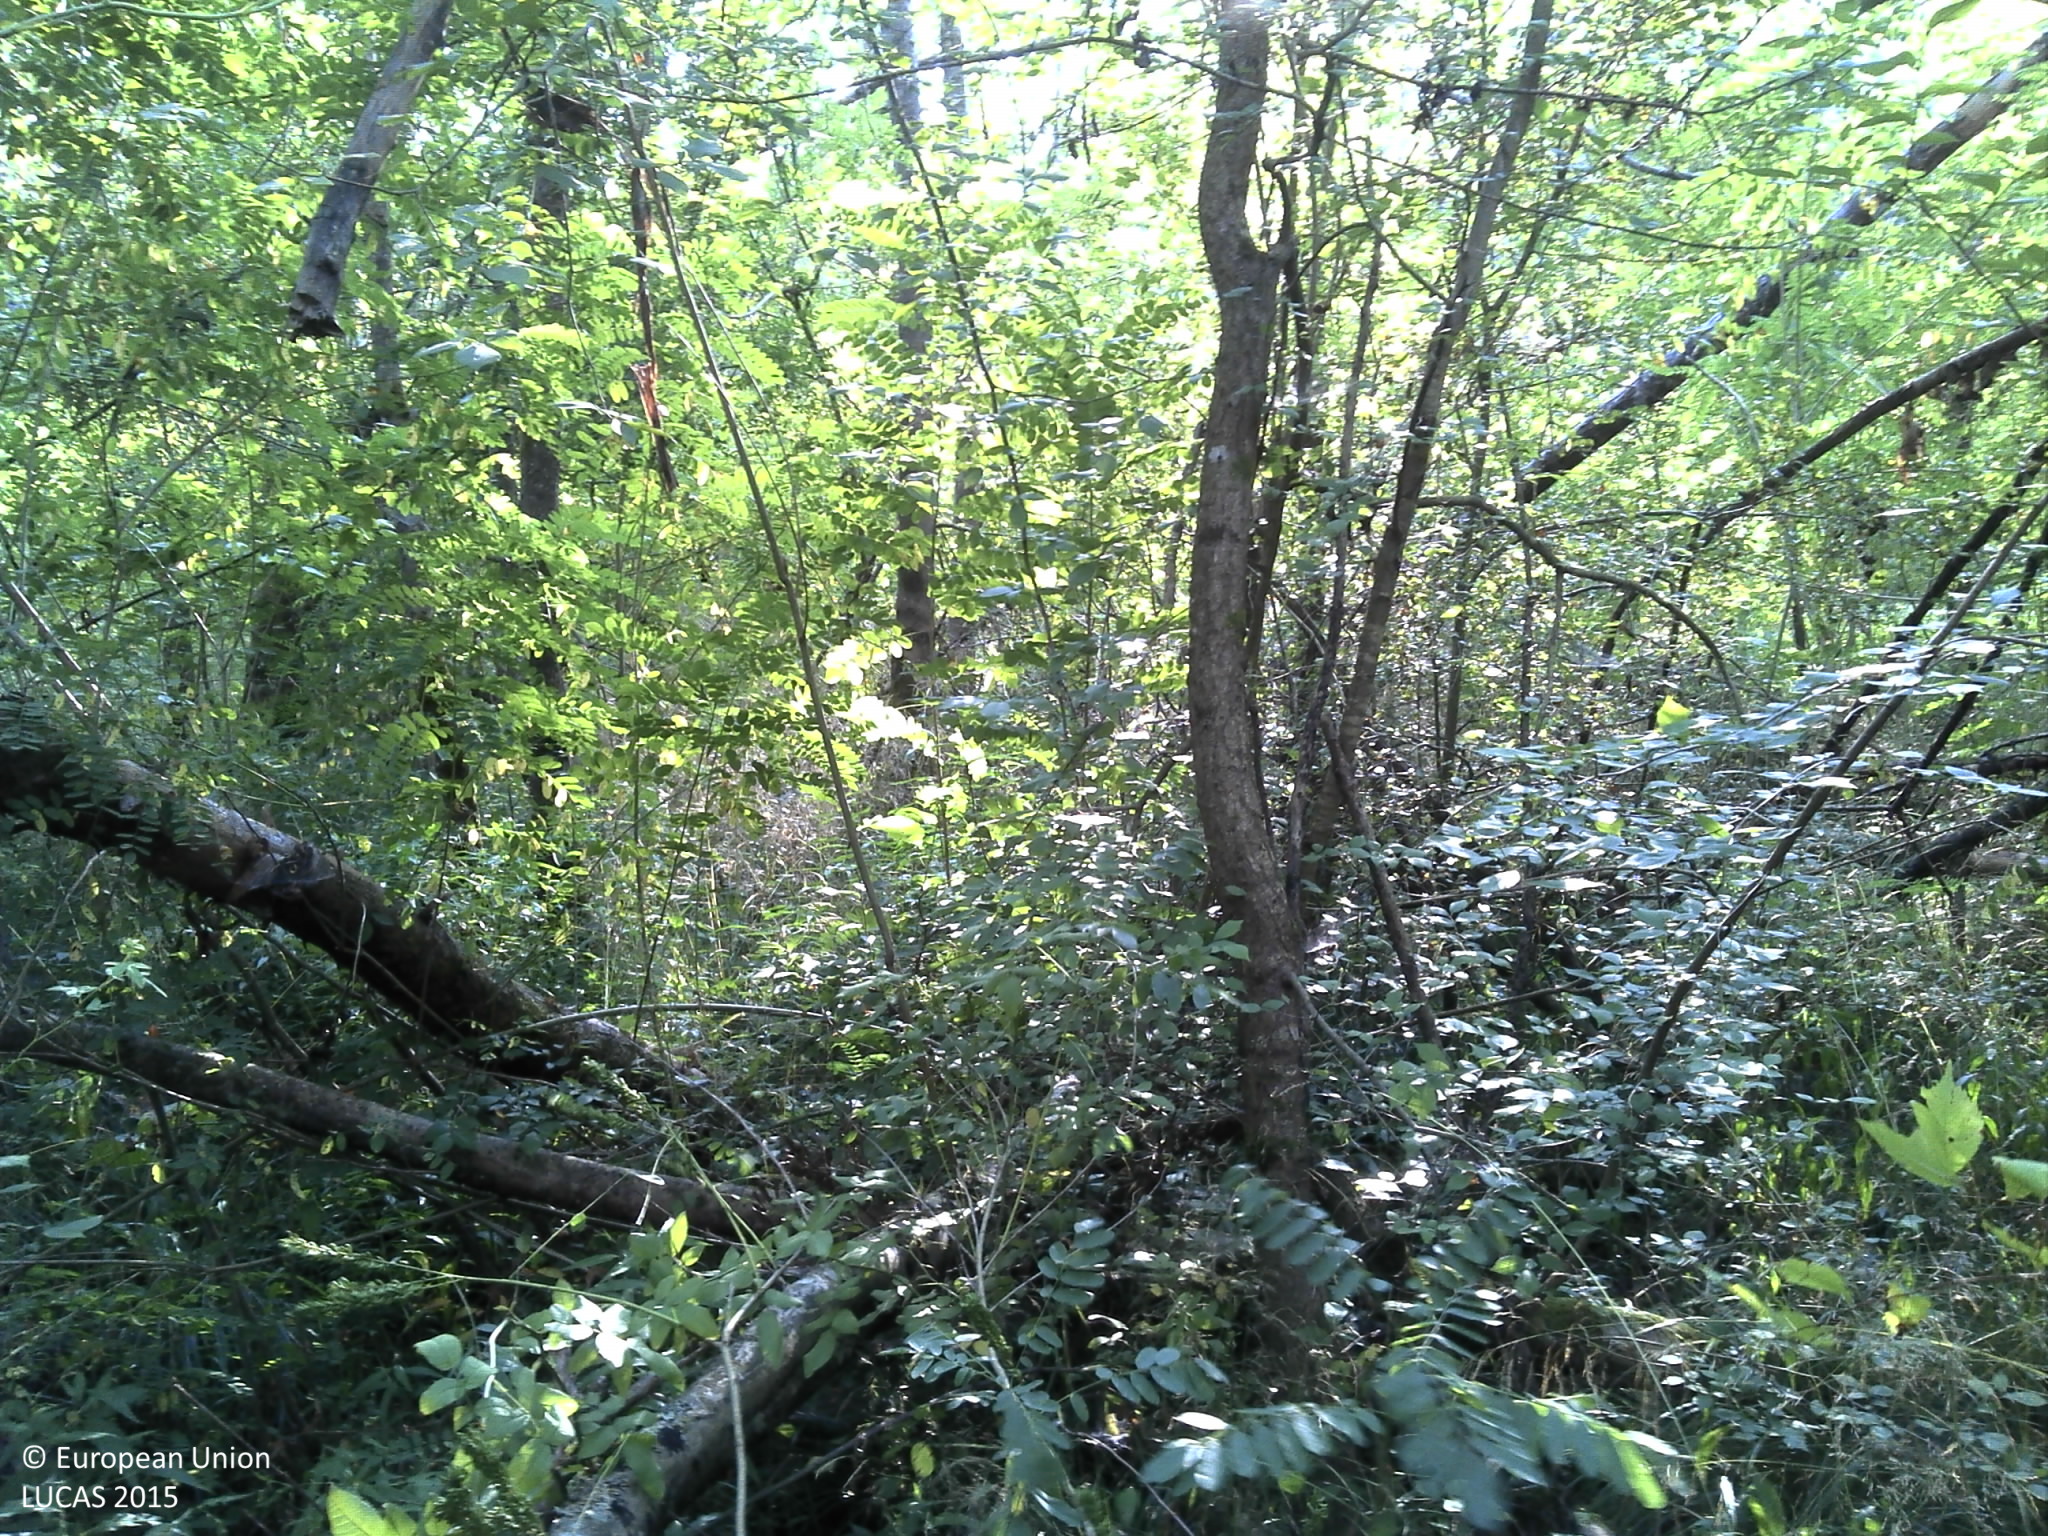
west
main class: Woodland
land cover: Broadleaved woodland
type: acidophilous oak and oak-birch forest
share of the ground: > 75 %
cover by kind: broadleaved forest trees 100 %
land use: Forestry
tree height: > 5 m
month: August
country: HR
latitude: 45.2904
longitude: 16.7176
